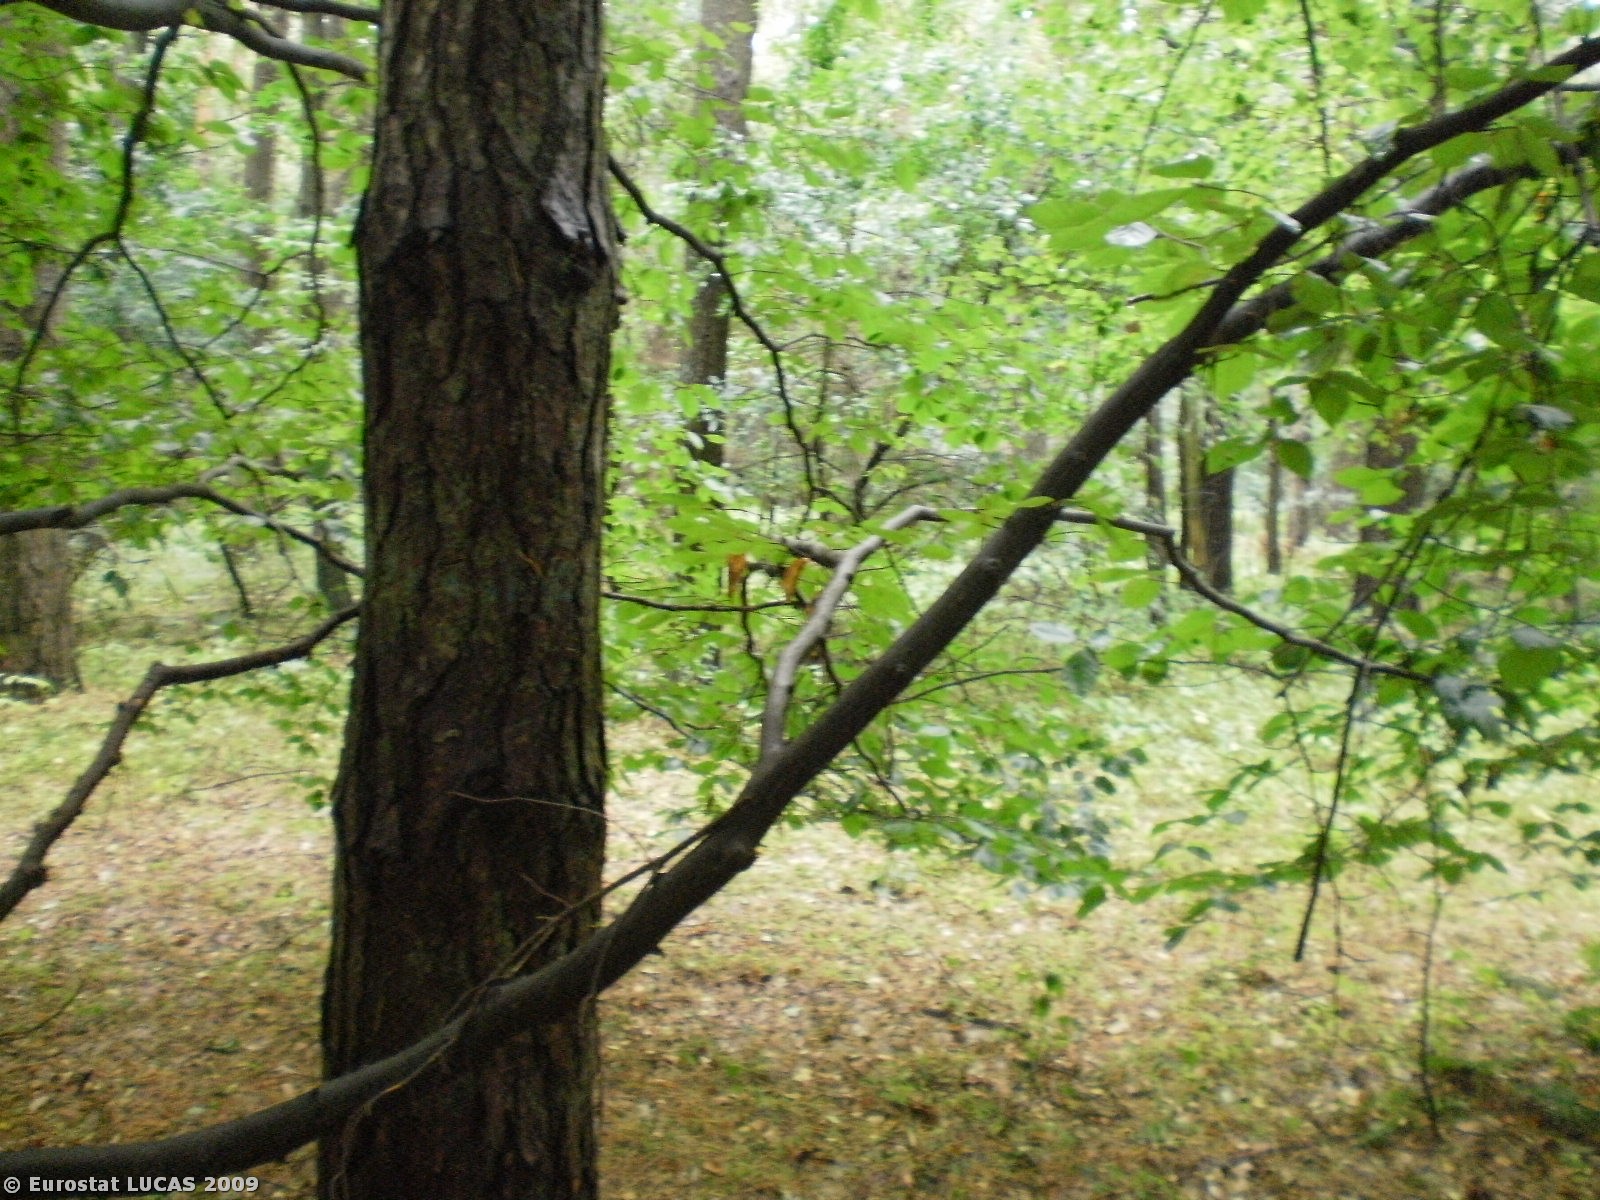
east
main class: Woodland
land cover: Mixed woodland
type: hemiboreal forest and nemoral coniferous forest and mixed broadleaved-coniferous forest
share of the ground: > 75 %
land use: Forestry
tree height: > 5 m
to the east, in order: Mixed woodland
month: September
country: PL
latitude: 53.7149
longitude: 17.7253
